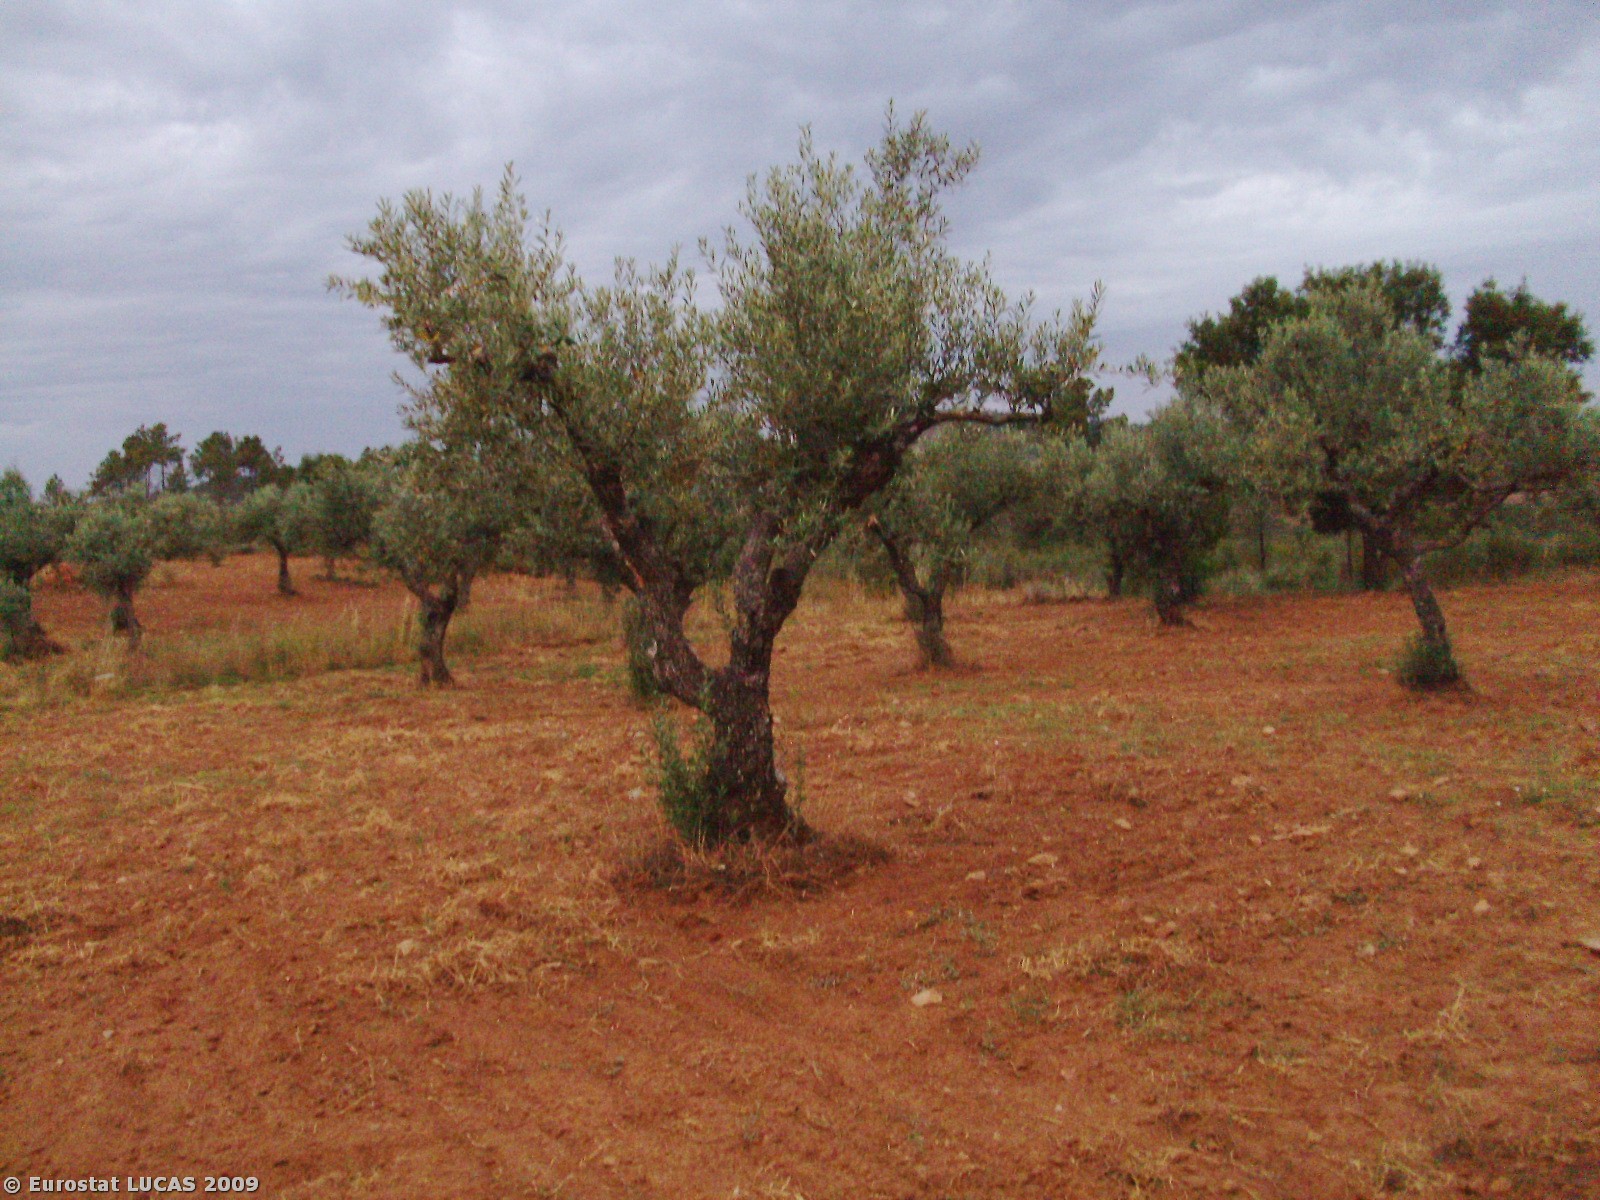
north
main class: Cropland
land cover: Olive groves
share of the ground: 50 - 75 %
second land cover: Bare land
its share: 25 - 50 %
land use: Agriculture (excluding fallow land and kitchen gardens)
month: June
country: PT
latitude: 39.9229
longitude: -7.5710
